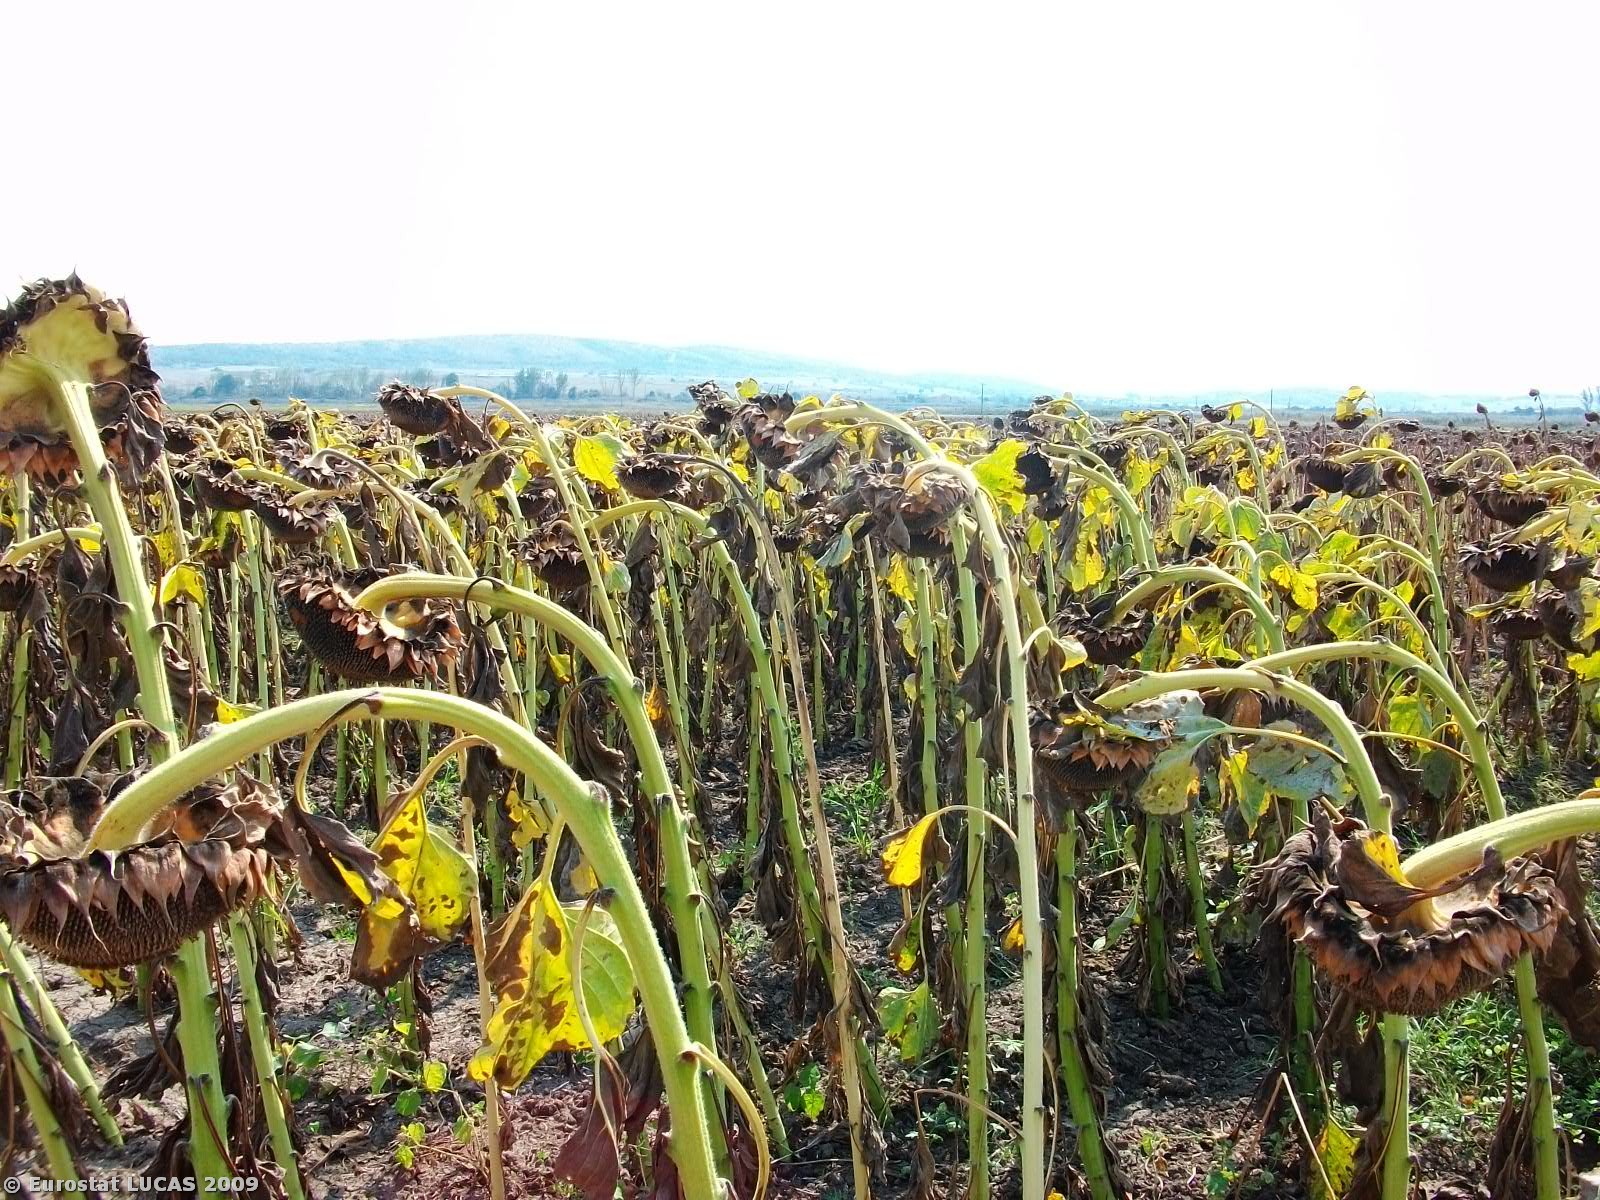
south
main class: Cropland
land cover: Sunflower
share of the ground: > 75 %
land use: Agriculture (excluding fallow land and kitchen gardens)
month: September
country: GR
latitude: 40.9933
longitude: 26.2930
